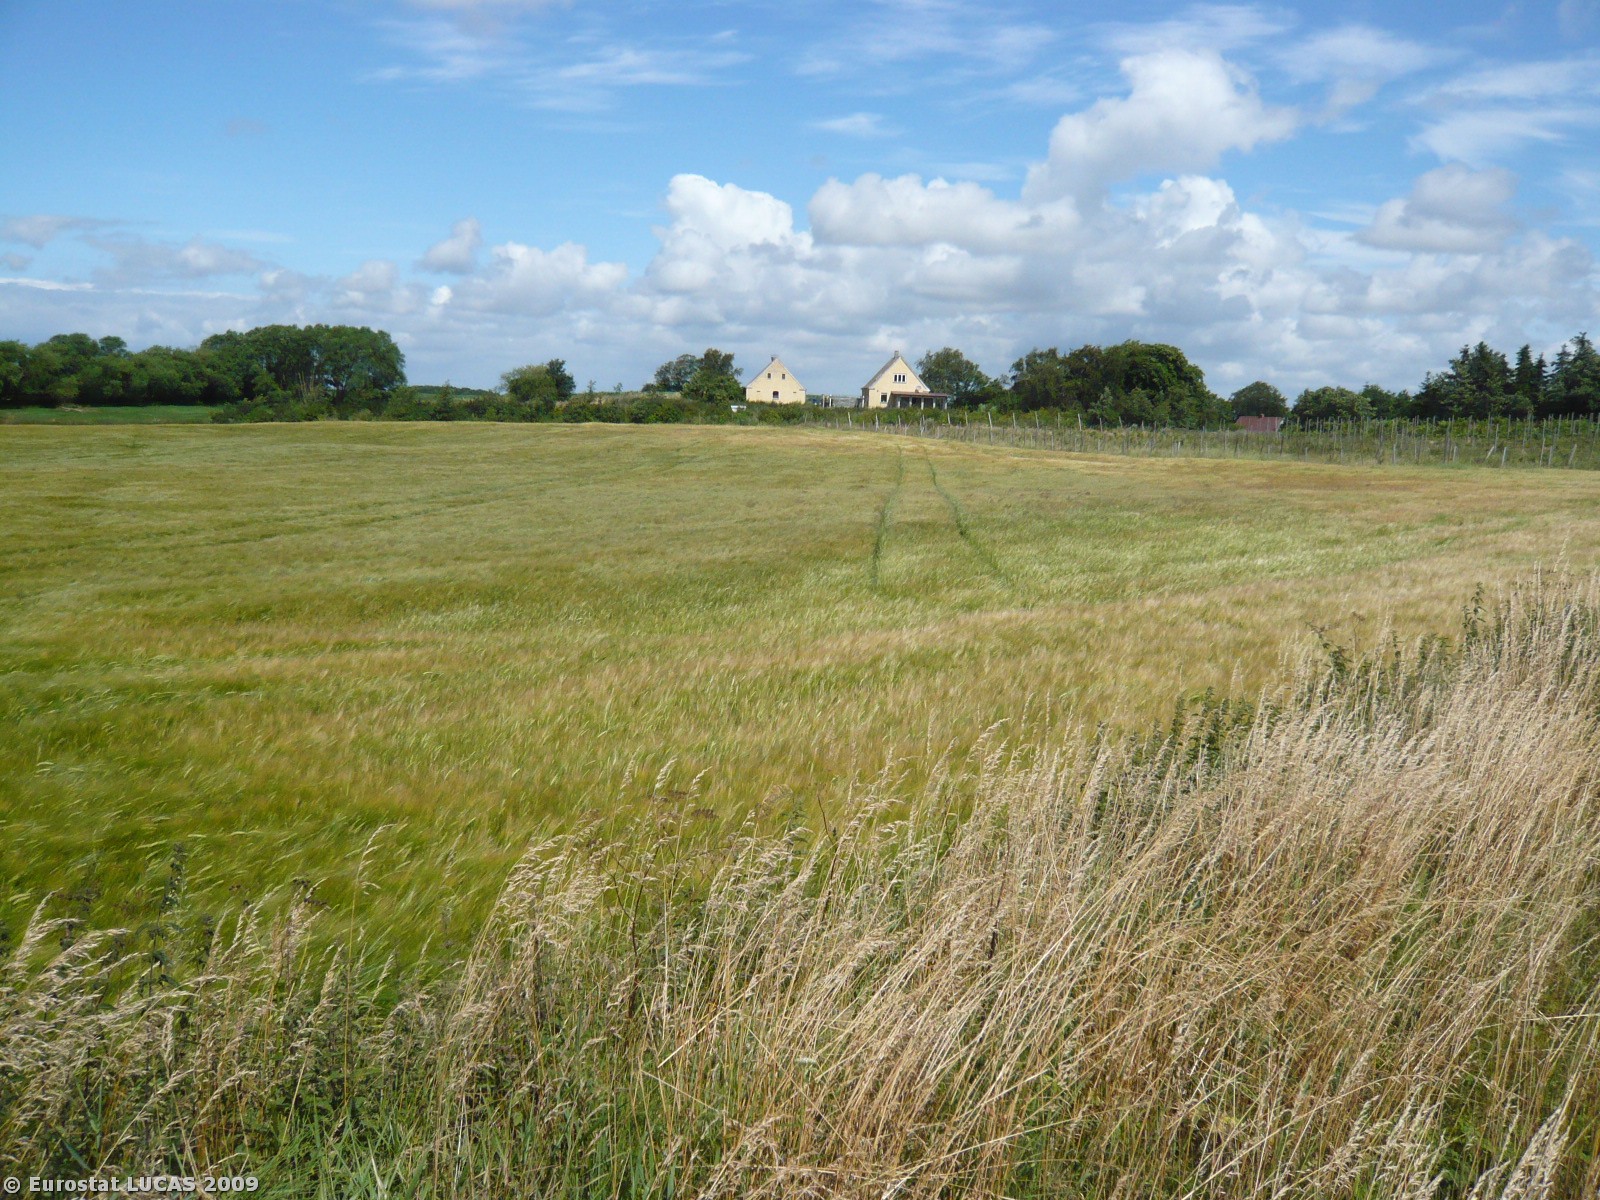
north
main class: Cropland
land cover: Barley
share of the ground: > 75 %
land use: Agriculture (excluding fallow land and kitchen gardens)
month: July
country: DK
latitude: 55.4796
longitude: 11.3437
